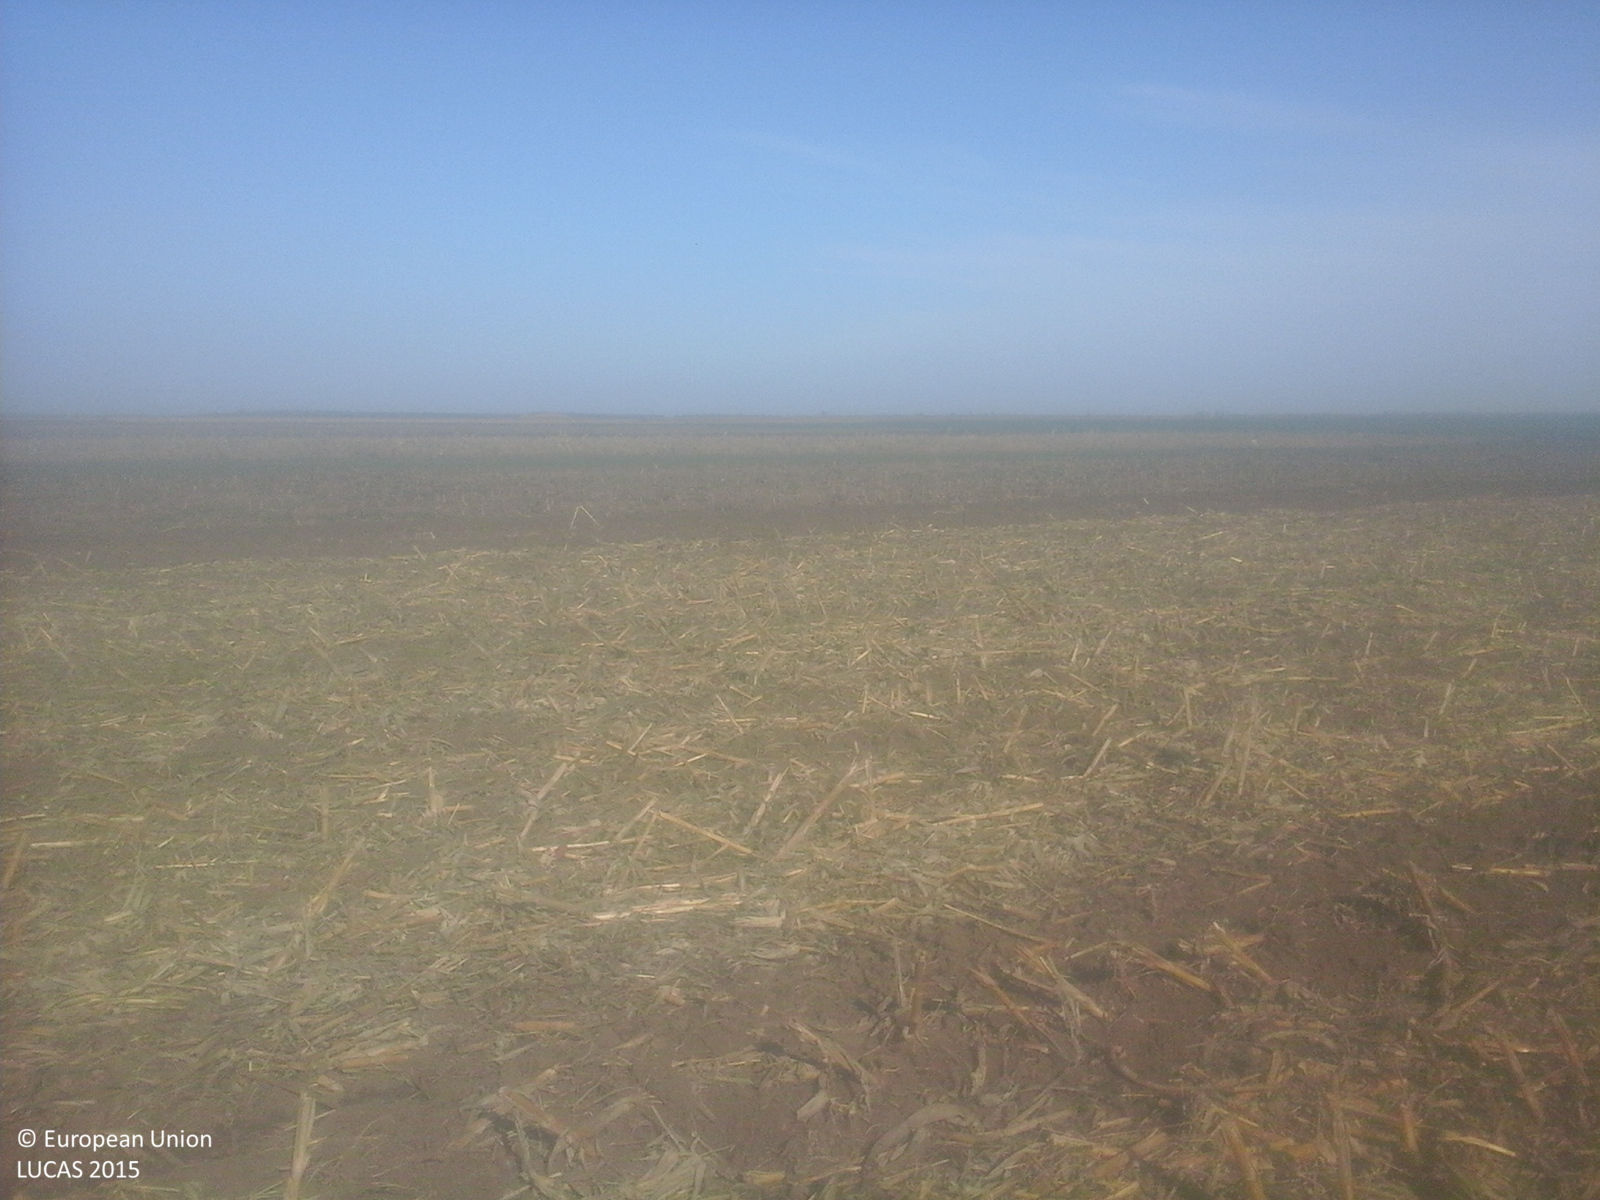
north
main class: Cropland
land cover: Maize
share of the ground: 50 - 75 %
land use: Agriculture (excluding fallow land and kitchen gardens)
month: October
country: RO
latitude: 45.4486
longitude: 27.2666
